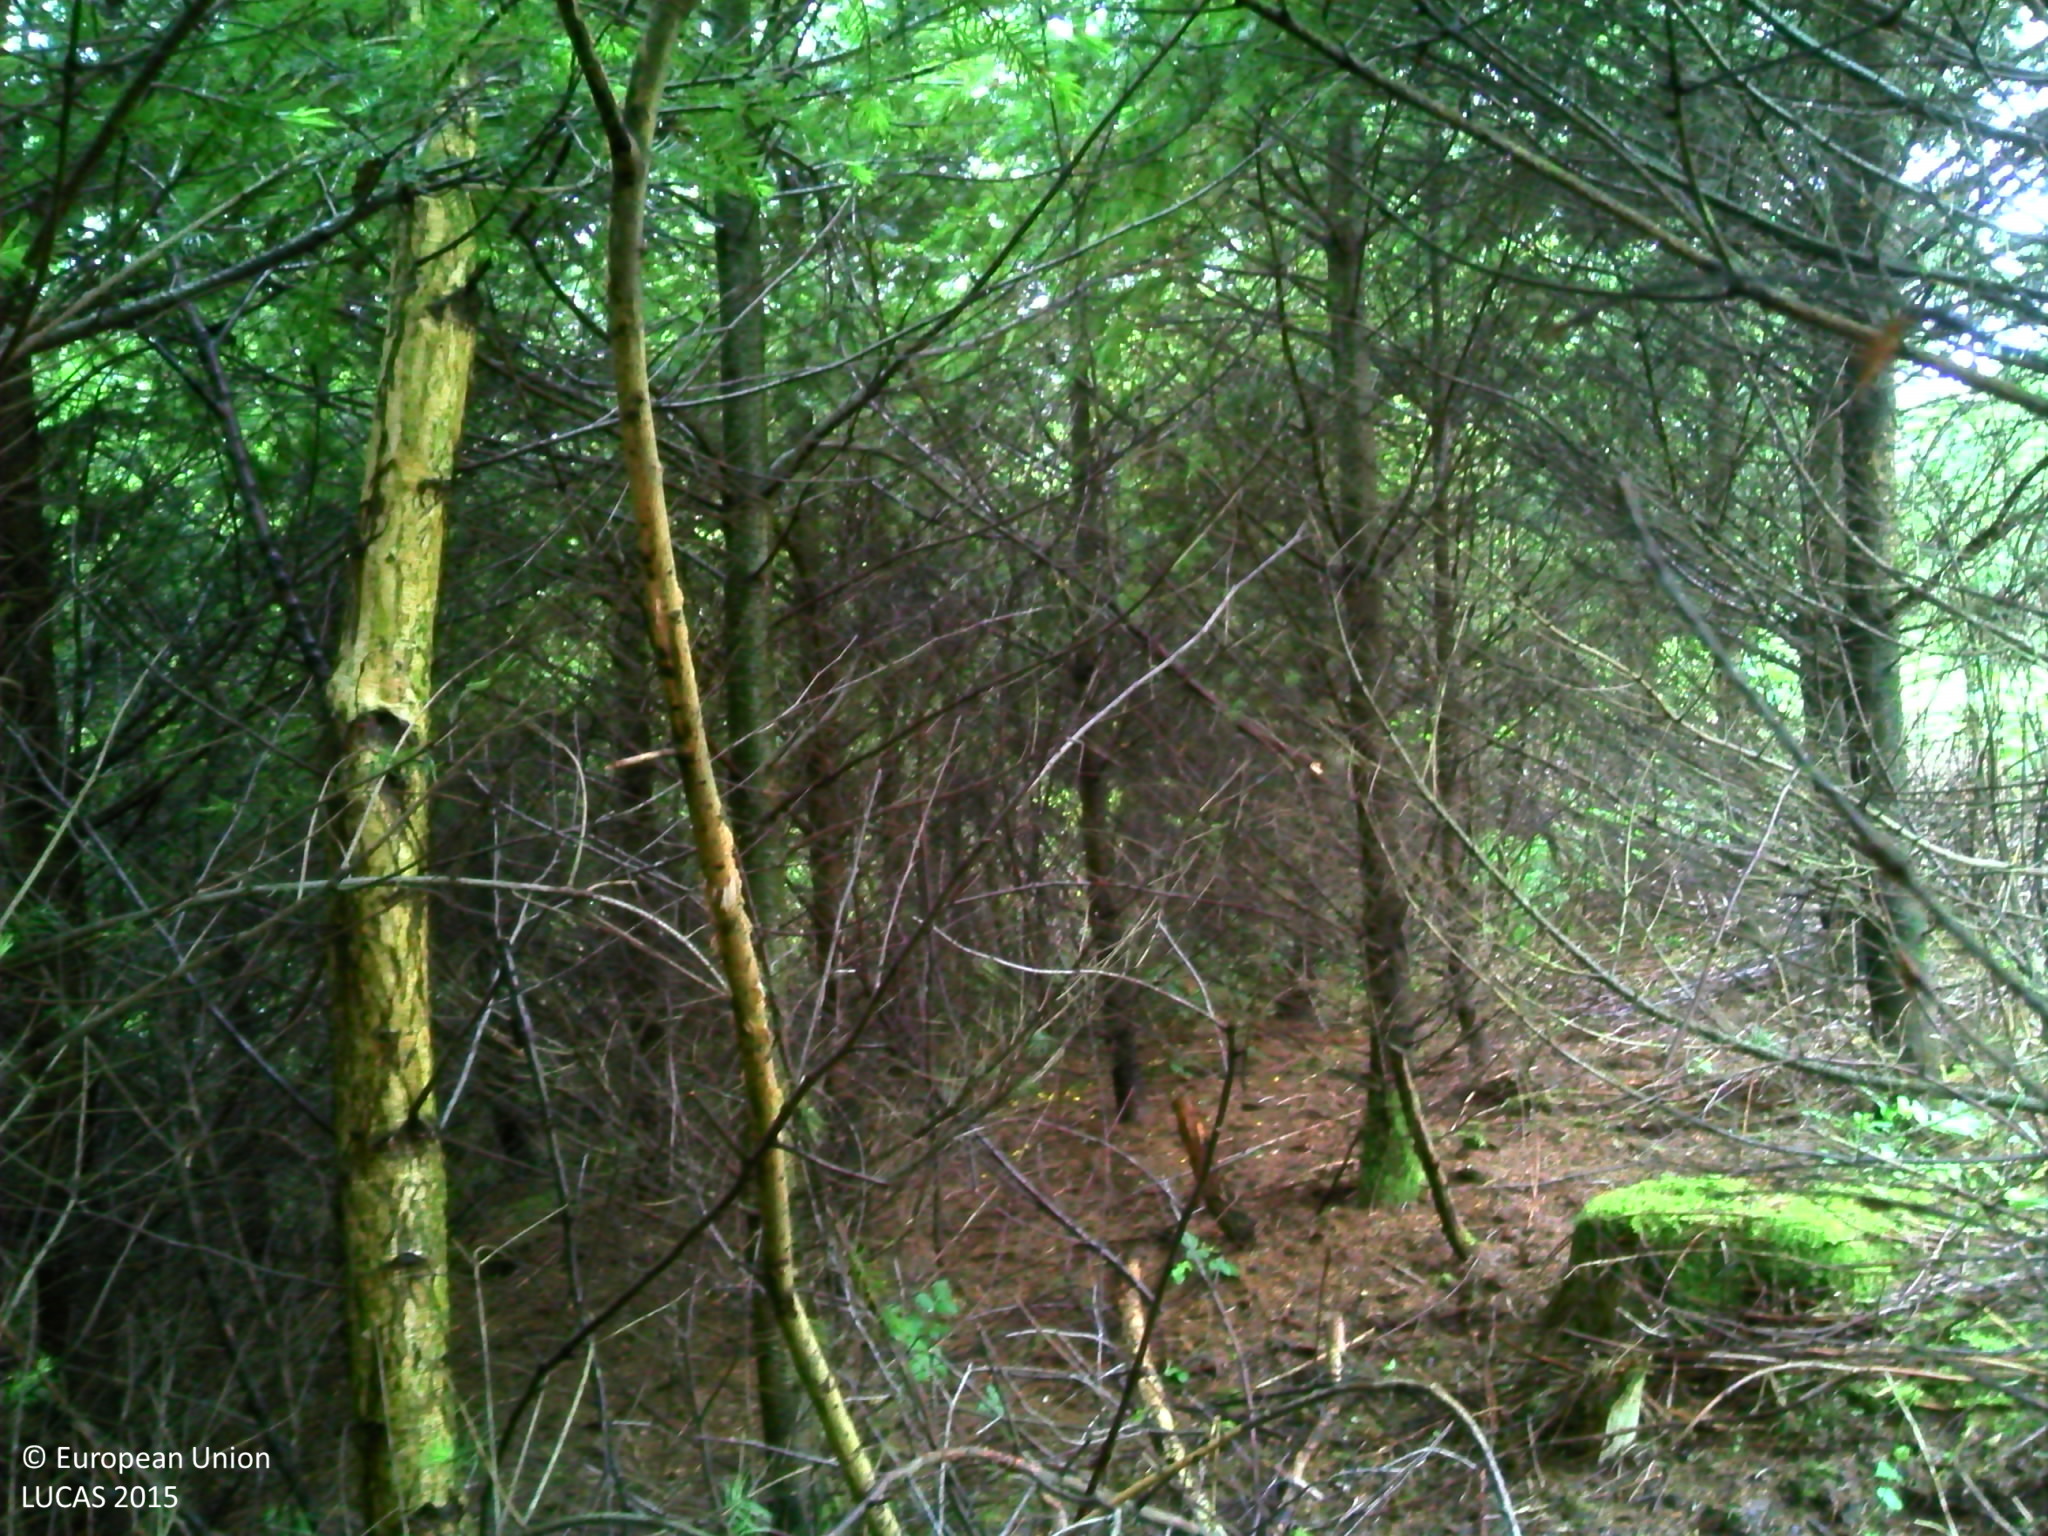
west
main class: Woodland
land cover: Other coniferous woodland
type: exotic forest
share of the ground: > 75 %
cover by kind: coniferous forest trees 85 %, broadleaved forest trees 10 %, lichens and mosses 5 %
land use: Forestry
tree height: > 5 m
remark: Burnt area
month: June
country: BE
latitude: 50.3388
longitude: 5.7414
